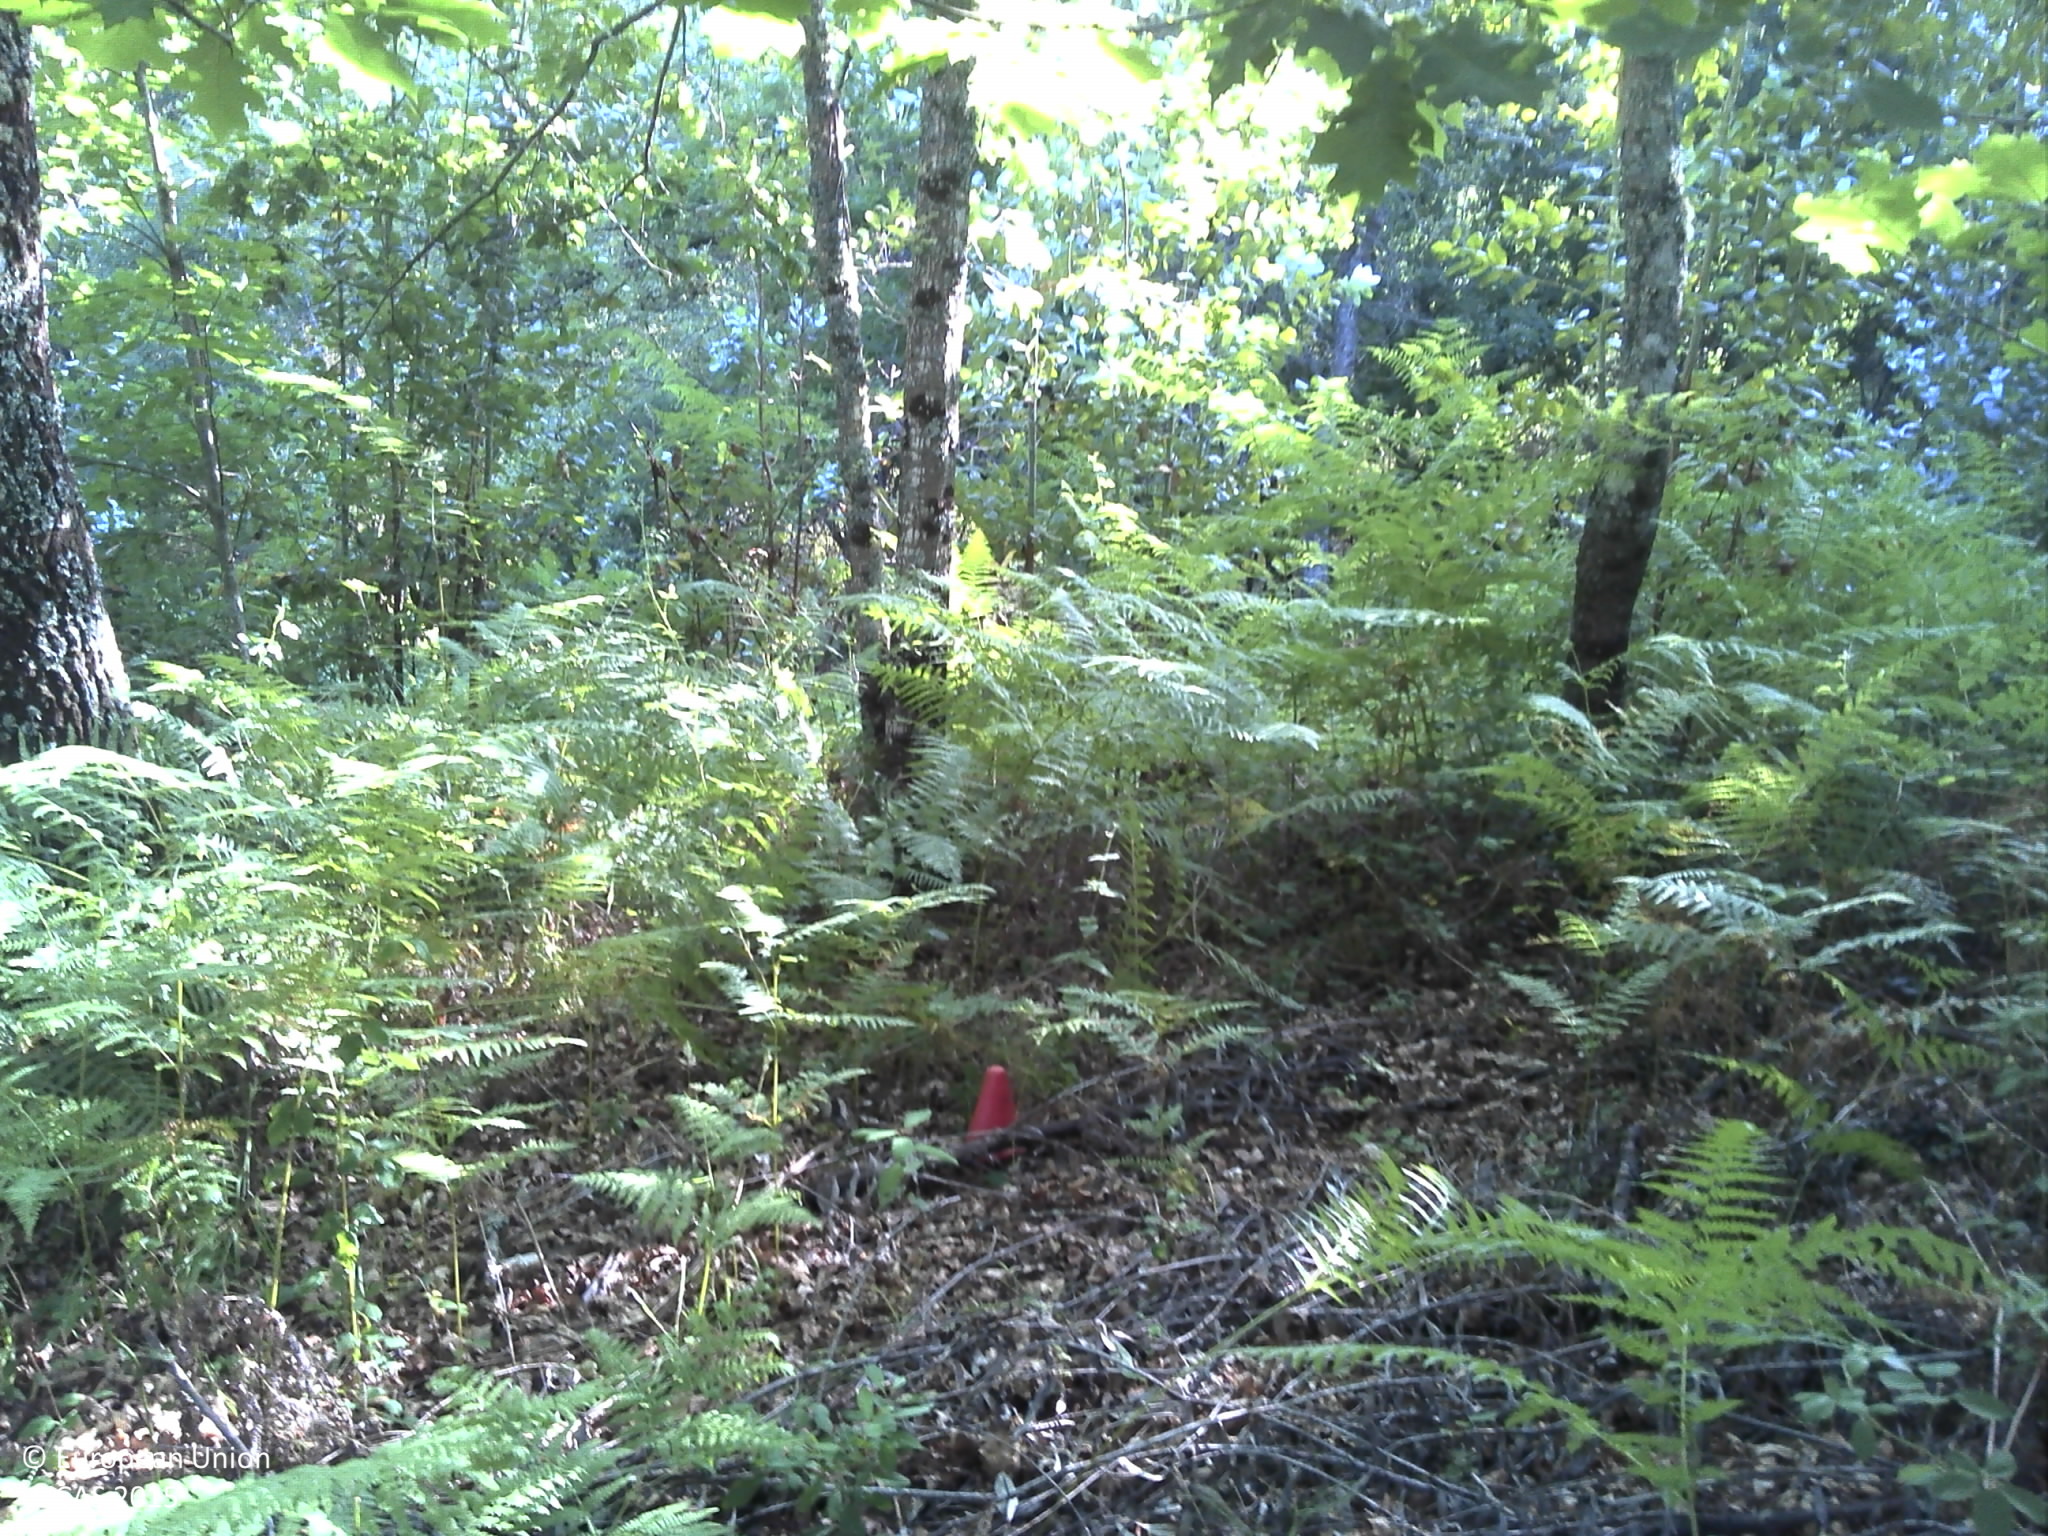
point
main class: Woodland
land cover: Broadleaved woodland
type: thermophilous deciduous forest
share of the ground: 25 - 50 %
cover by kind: unconsolidated bare surface 40 %, broadleaved forest trees 30 %, shrubs 30 %
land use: Forestry
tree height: > 5 m
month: June
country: PT
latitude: 39.9617
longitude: -8.1586
